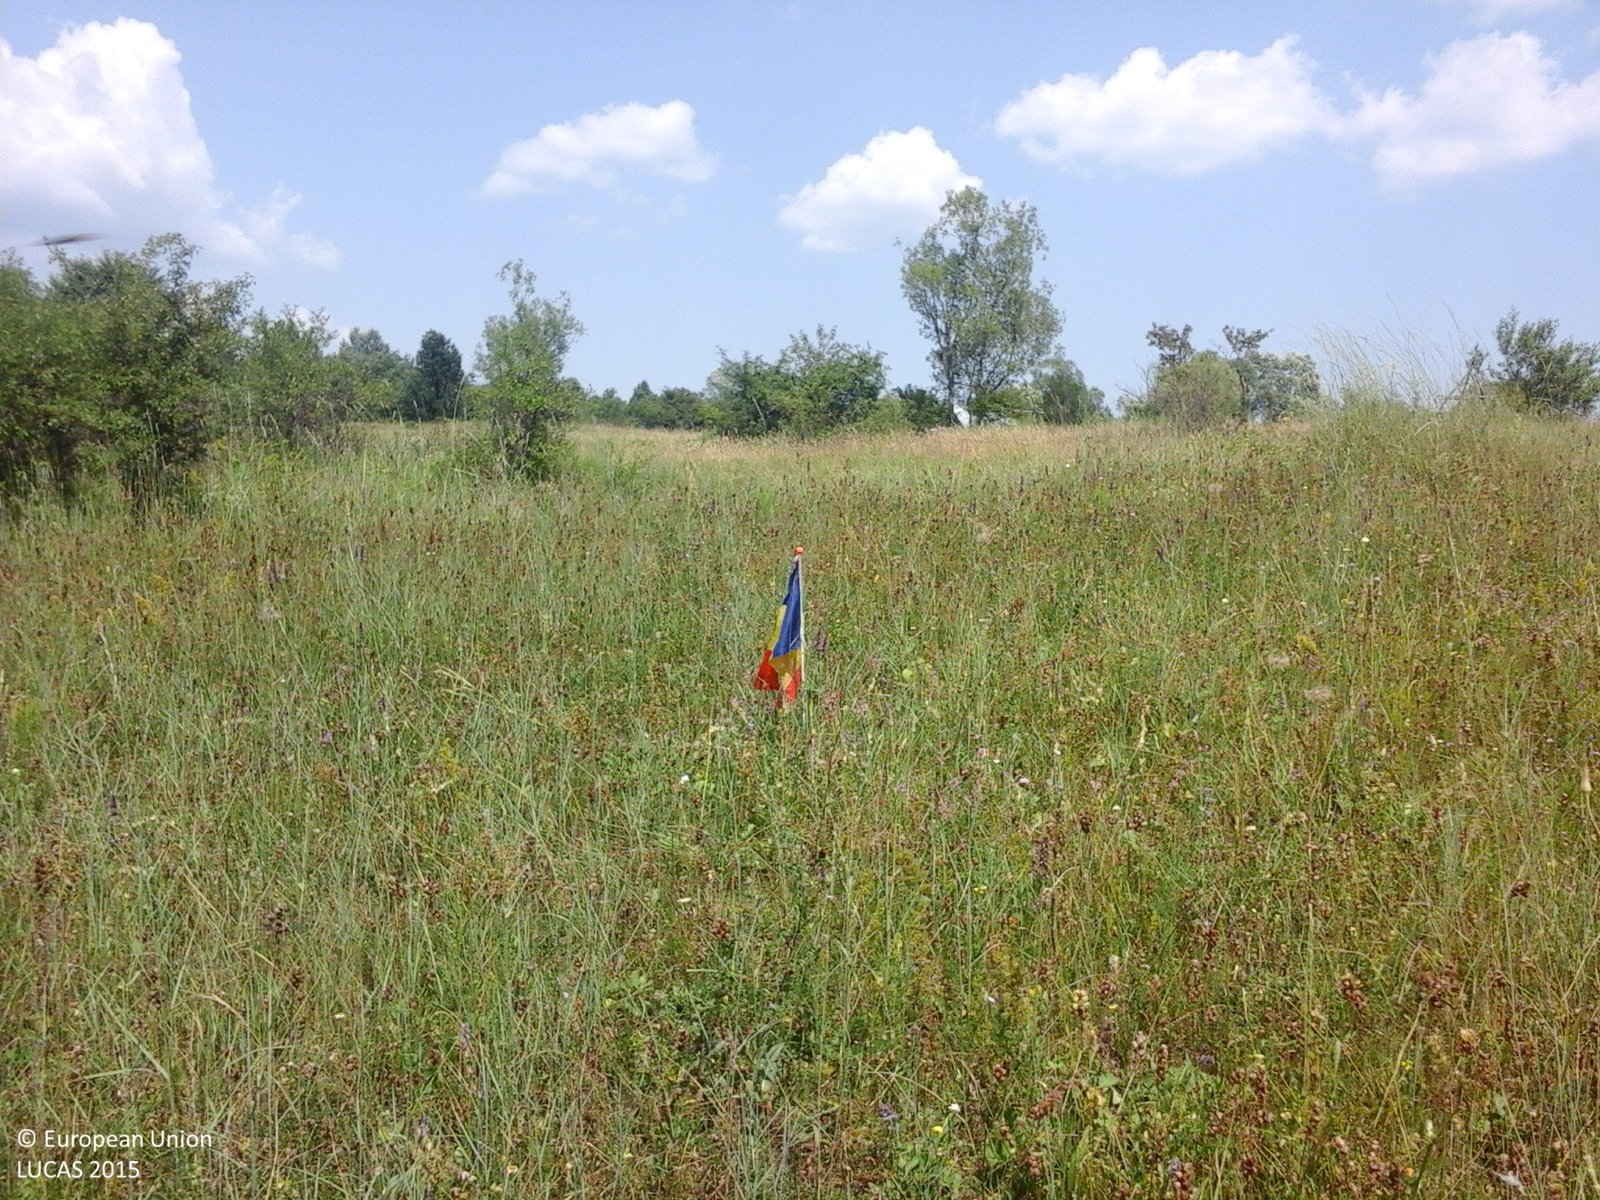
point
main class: Grassland
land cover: Grassland without tree/shrub cover
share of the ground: > 75 %
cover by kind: herbaceous plants 100 %
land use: Agriculture (excluding fallow land and kitchen gardens)
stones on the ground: < 10 %
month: July
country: RO
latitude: 45.1572
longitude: 24.6188
